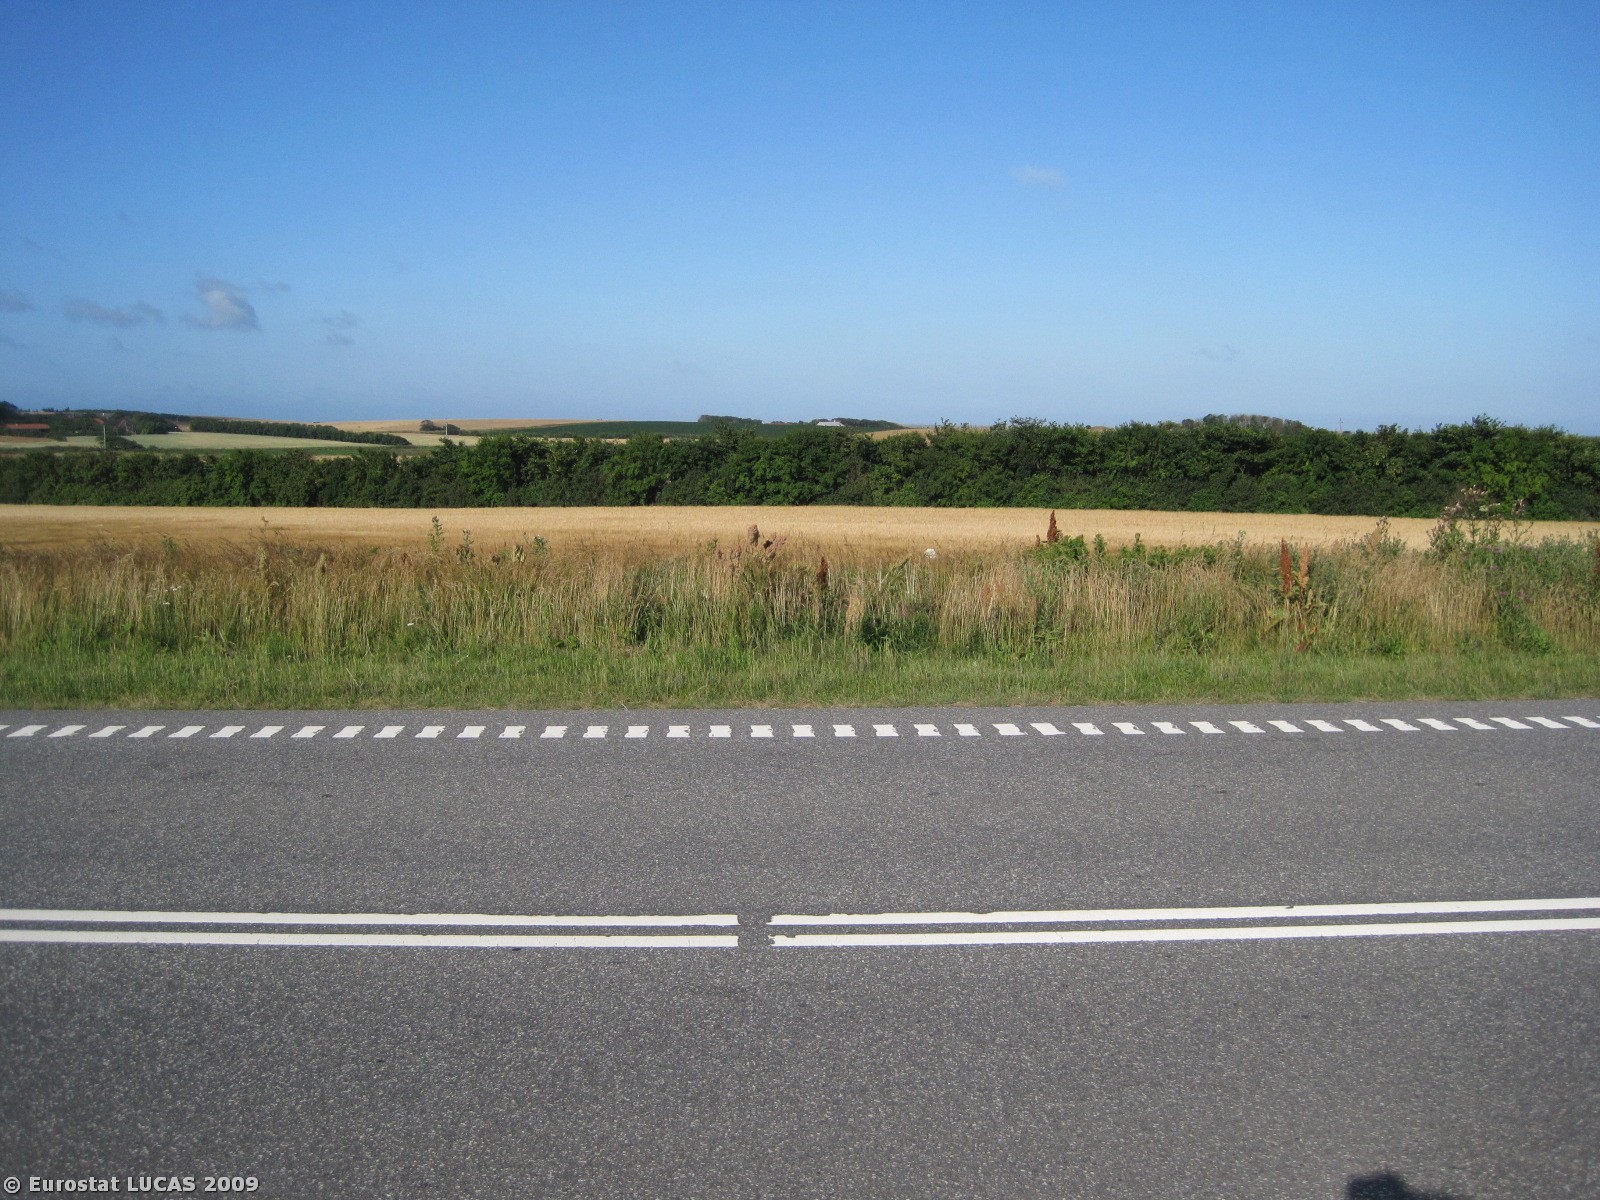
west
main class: Cropland
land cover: Barley
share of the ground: > 75 %
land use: Agriculture (excluding fallow land and kitchen gardens)
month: July
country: DK
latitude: 56.7701
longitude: 8.3170
